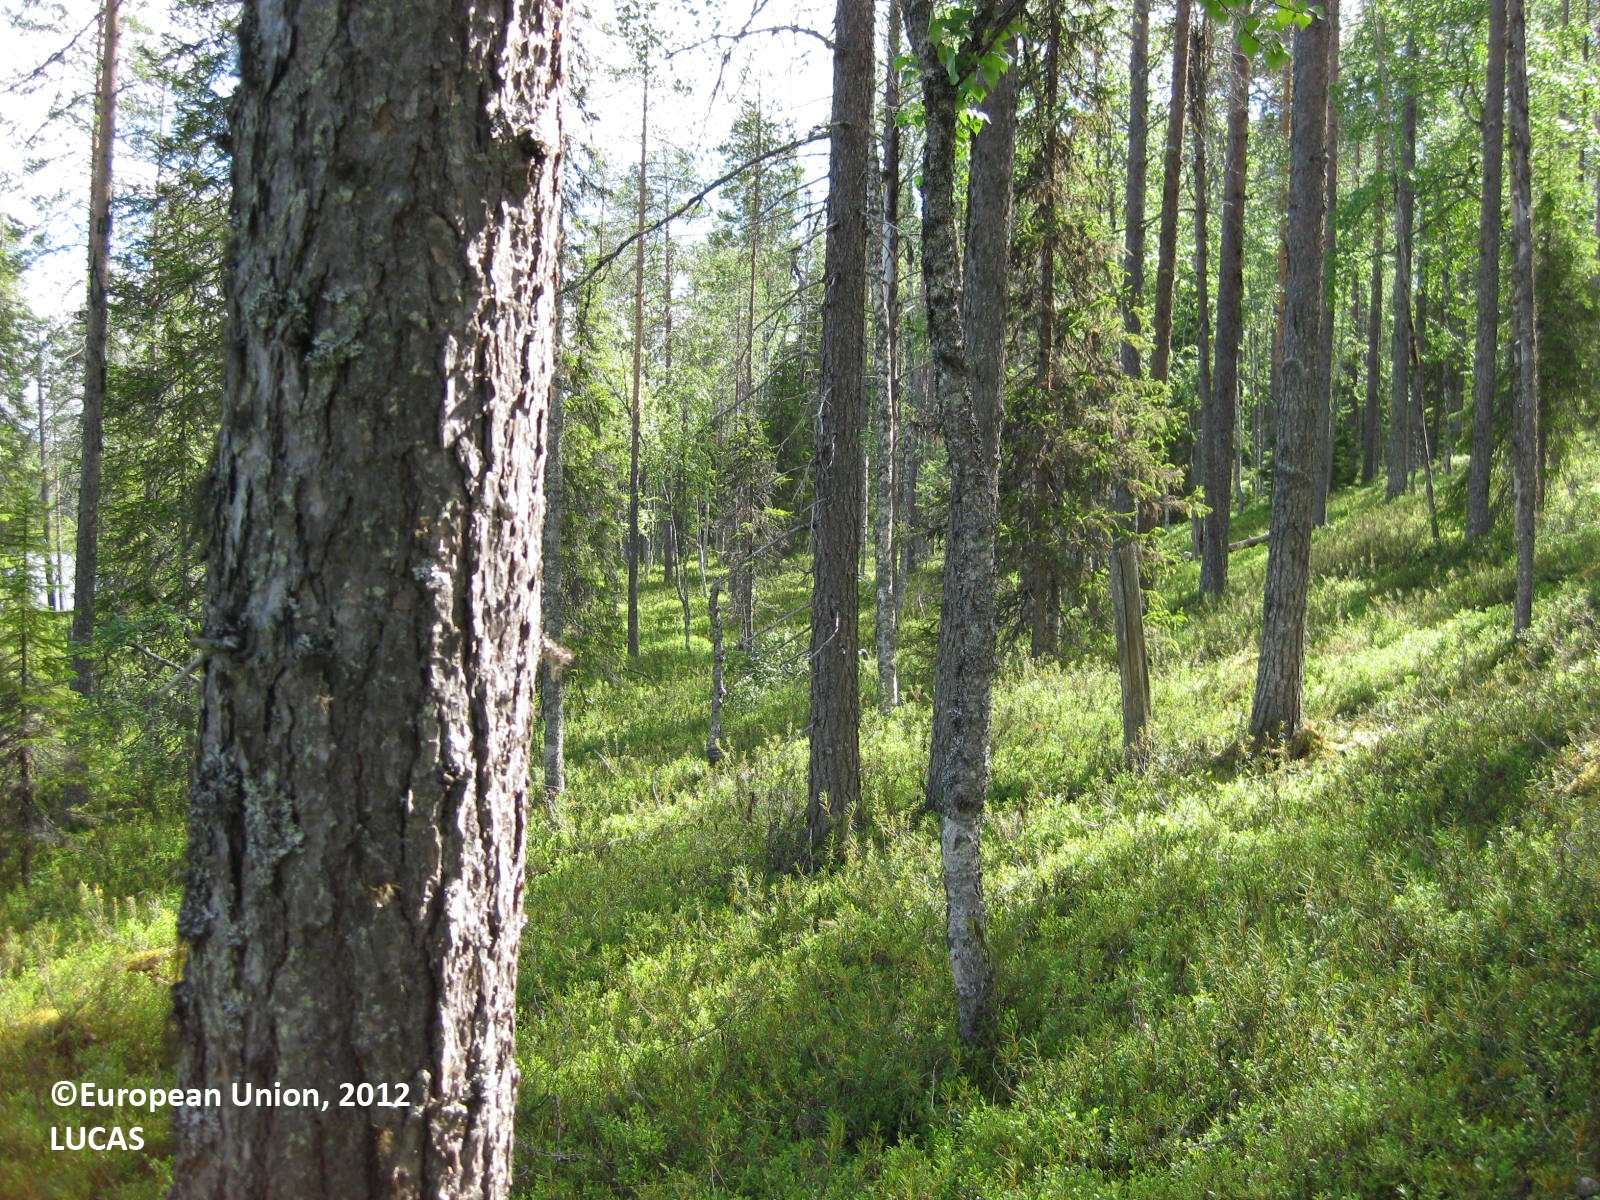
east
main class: Woodland
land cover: Pine dominated mixed woodland
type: boreal forest
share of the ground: > 75 %
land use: Forestry
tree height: > 5 m
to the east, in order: Pine dominated mixed woodland; Pine dominated coniferous woodland; Inland water bodies
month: July
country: FI
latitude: 65.6936
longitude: 29.8707
